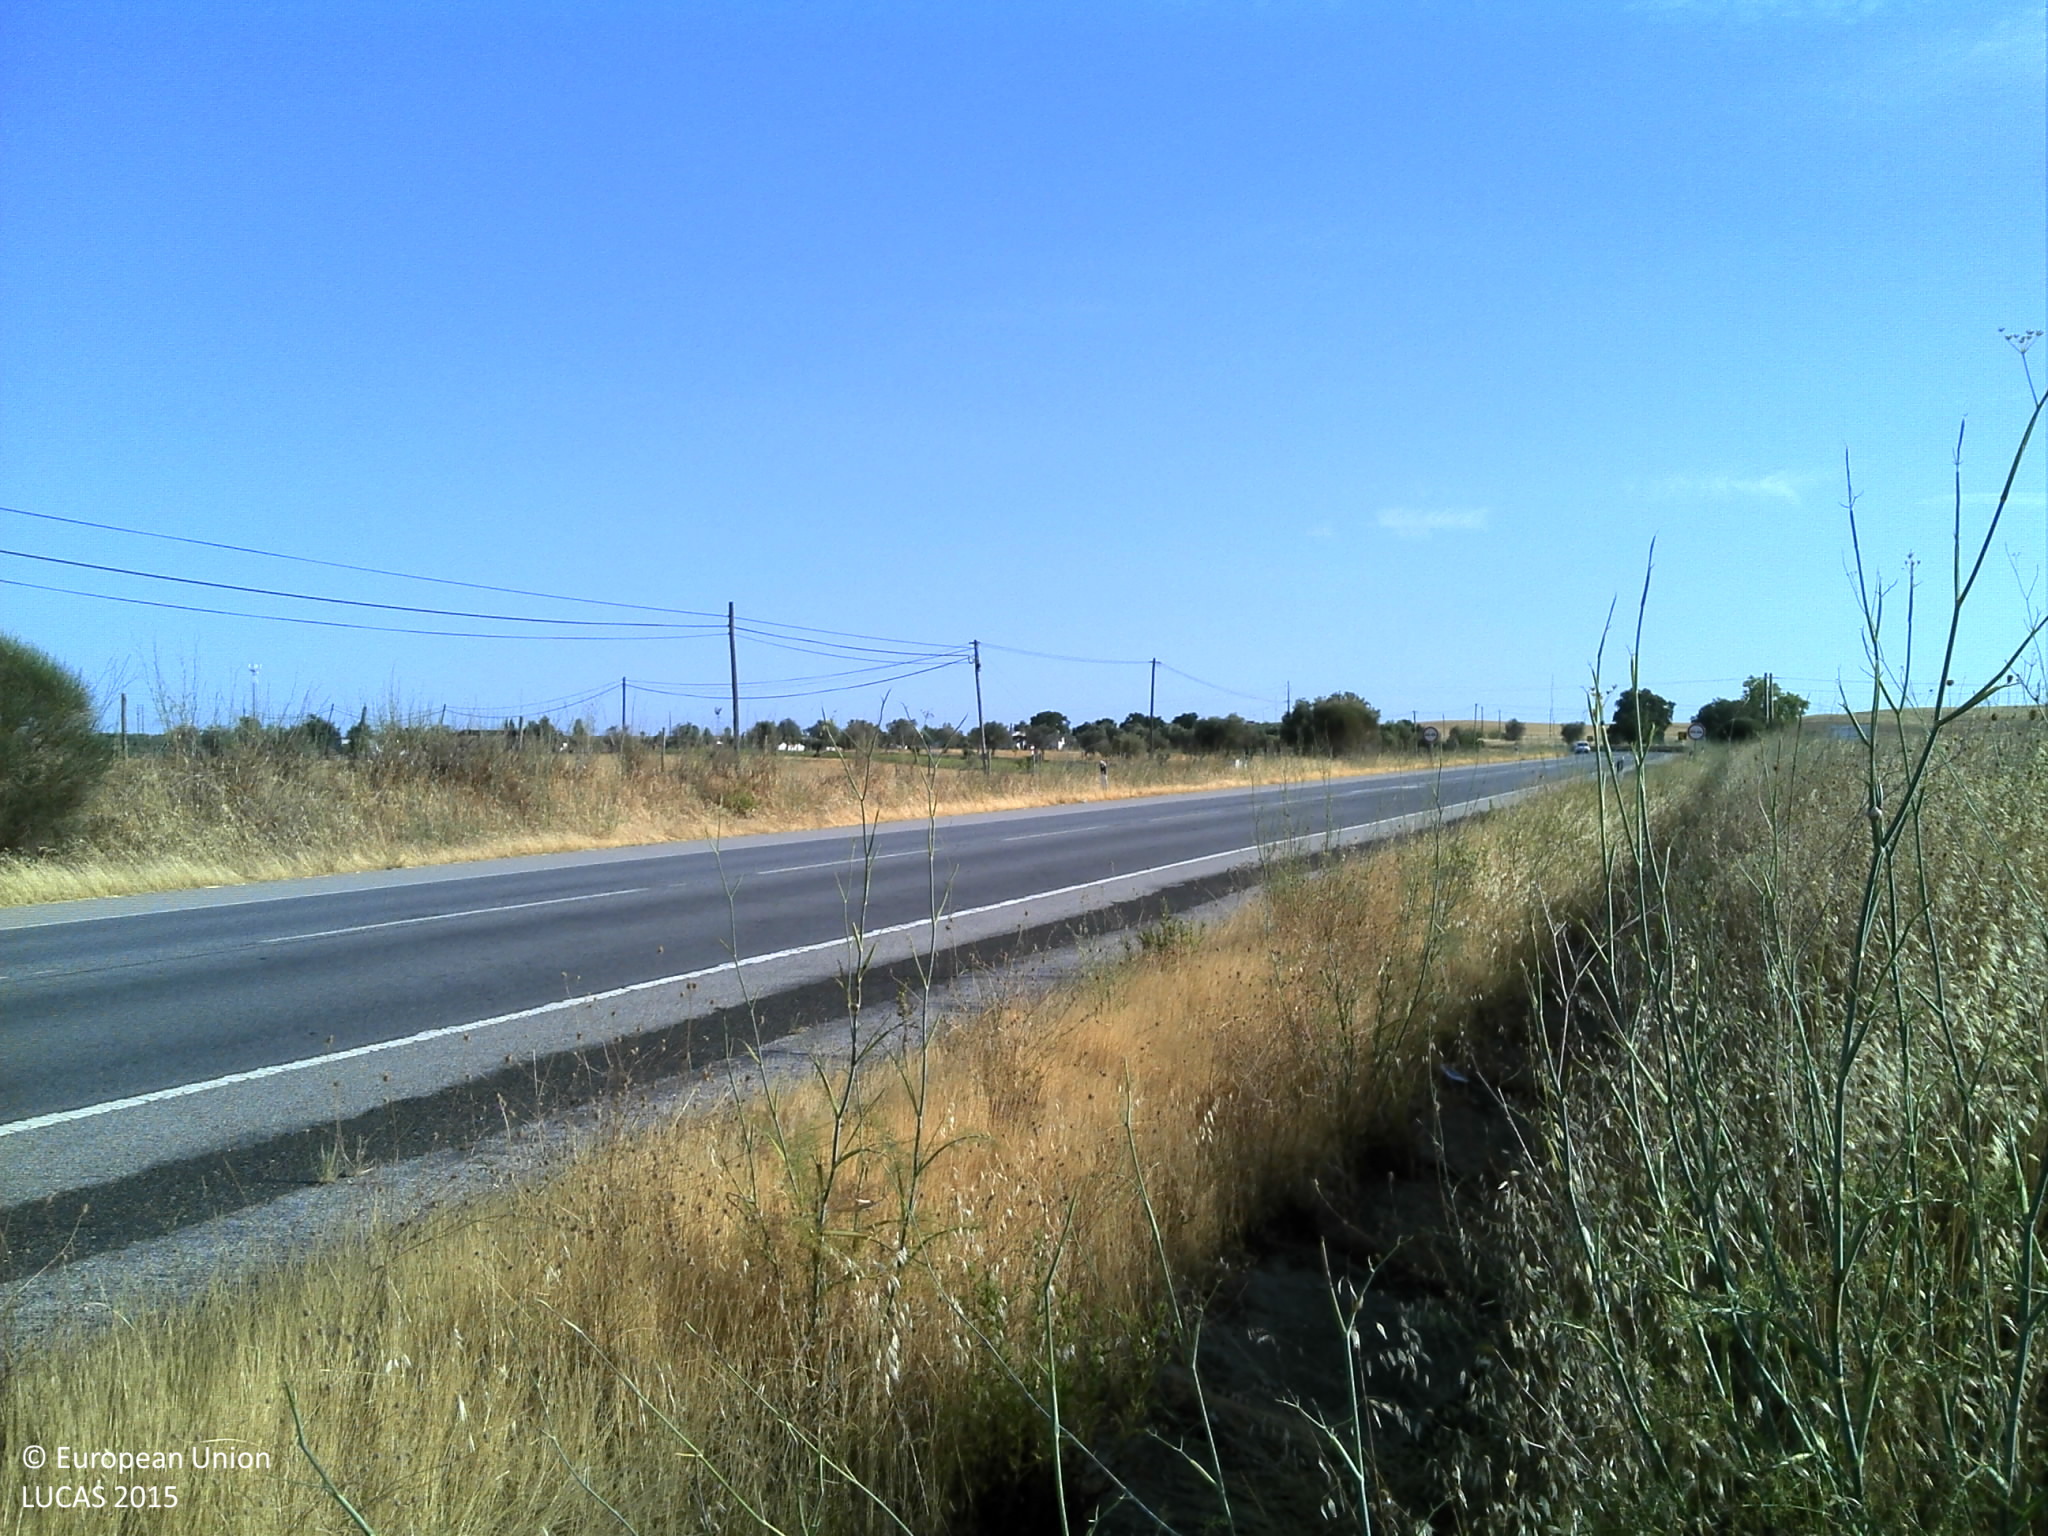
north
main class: Grassland
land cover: Grassland without tree/shrub cover
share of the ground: 50 - 75 %
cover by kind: herbaceous plants 70 %, unconsolidated bare surface 30 %
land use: Road transport
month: July
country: PT
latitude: 38.4870
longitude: -7.7464
